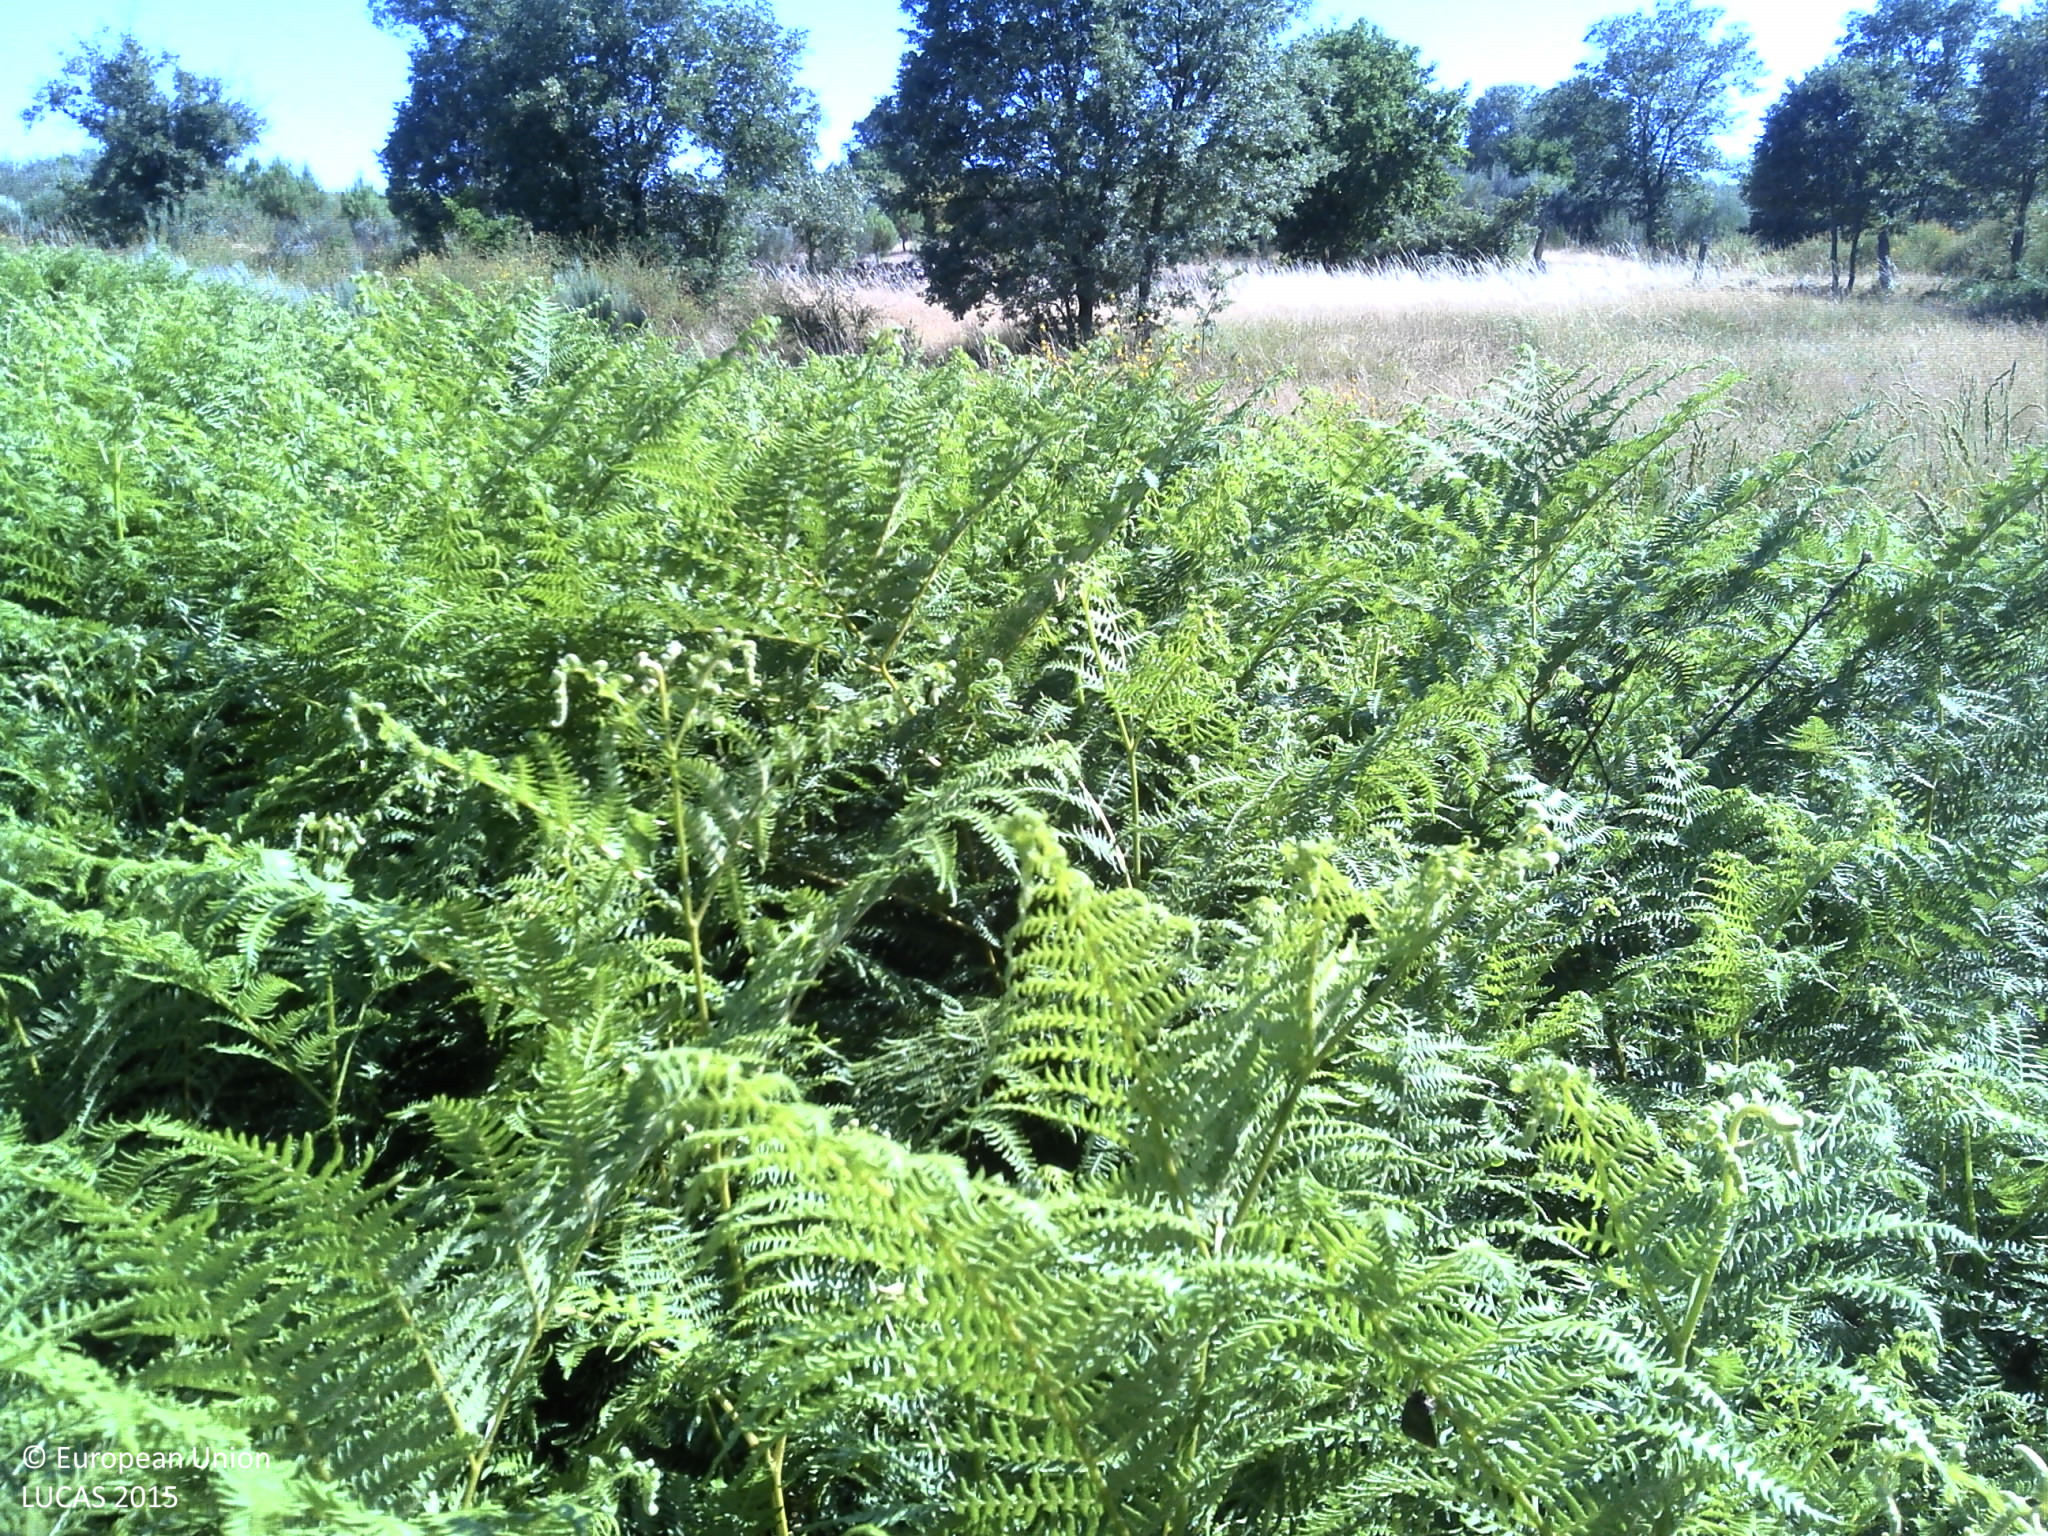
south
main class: Grassland
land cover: Spontaneously vegetated surfaces
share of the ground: > 75 %
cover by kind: herbaceous plants 90 %, shrubs 5 %, unconsolidated bare surface 5 %
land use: Fallow land
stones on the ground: < 10 %
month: July
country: PT
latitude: 41.7430
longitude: -7.6054
